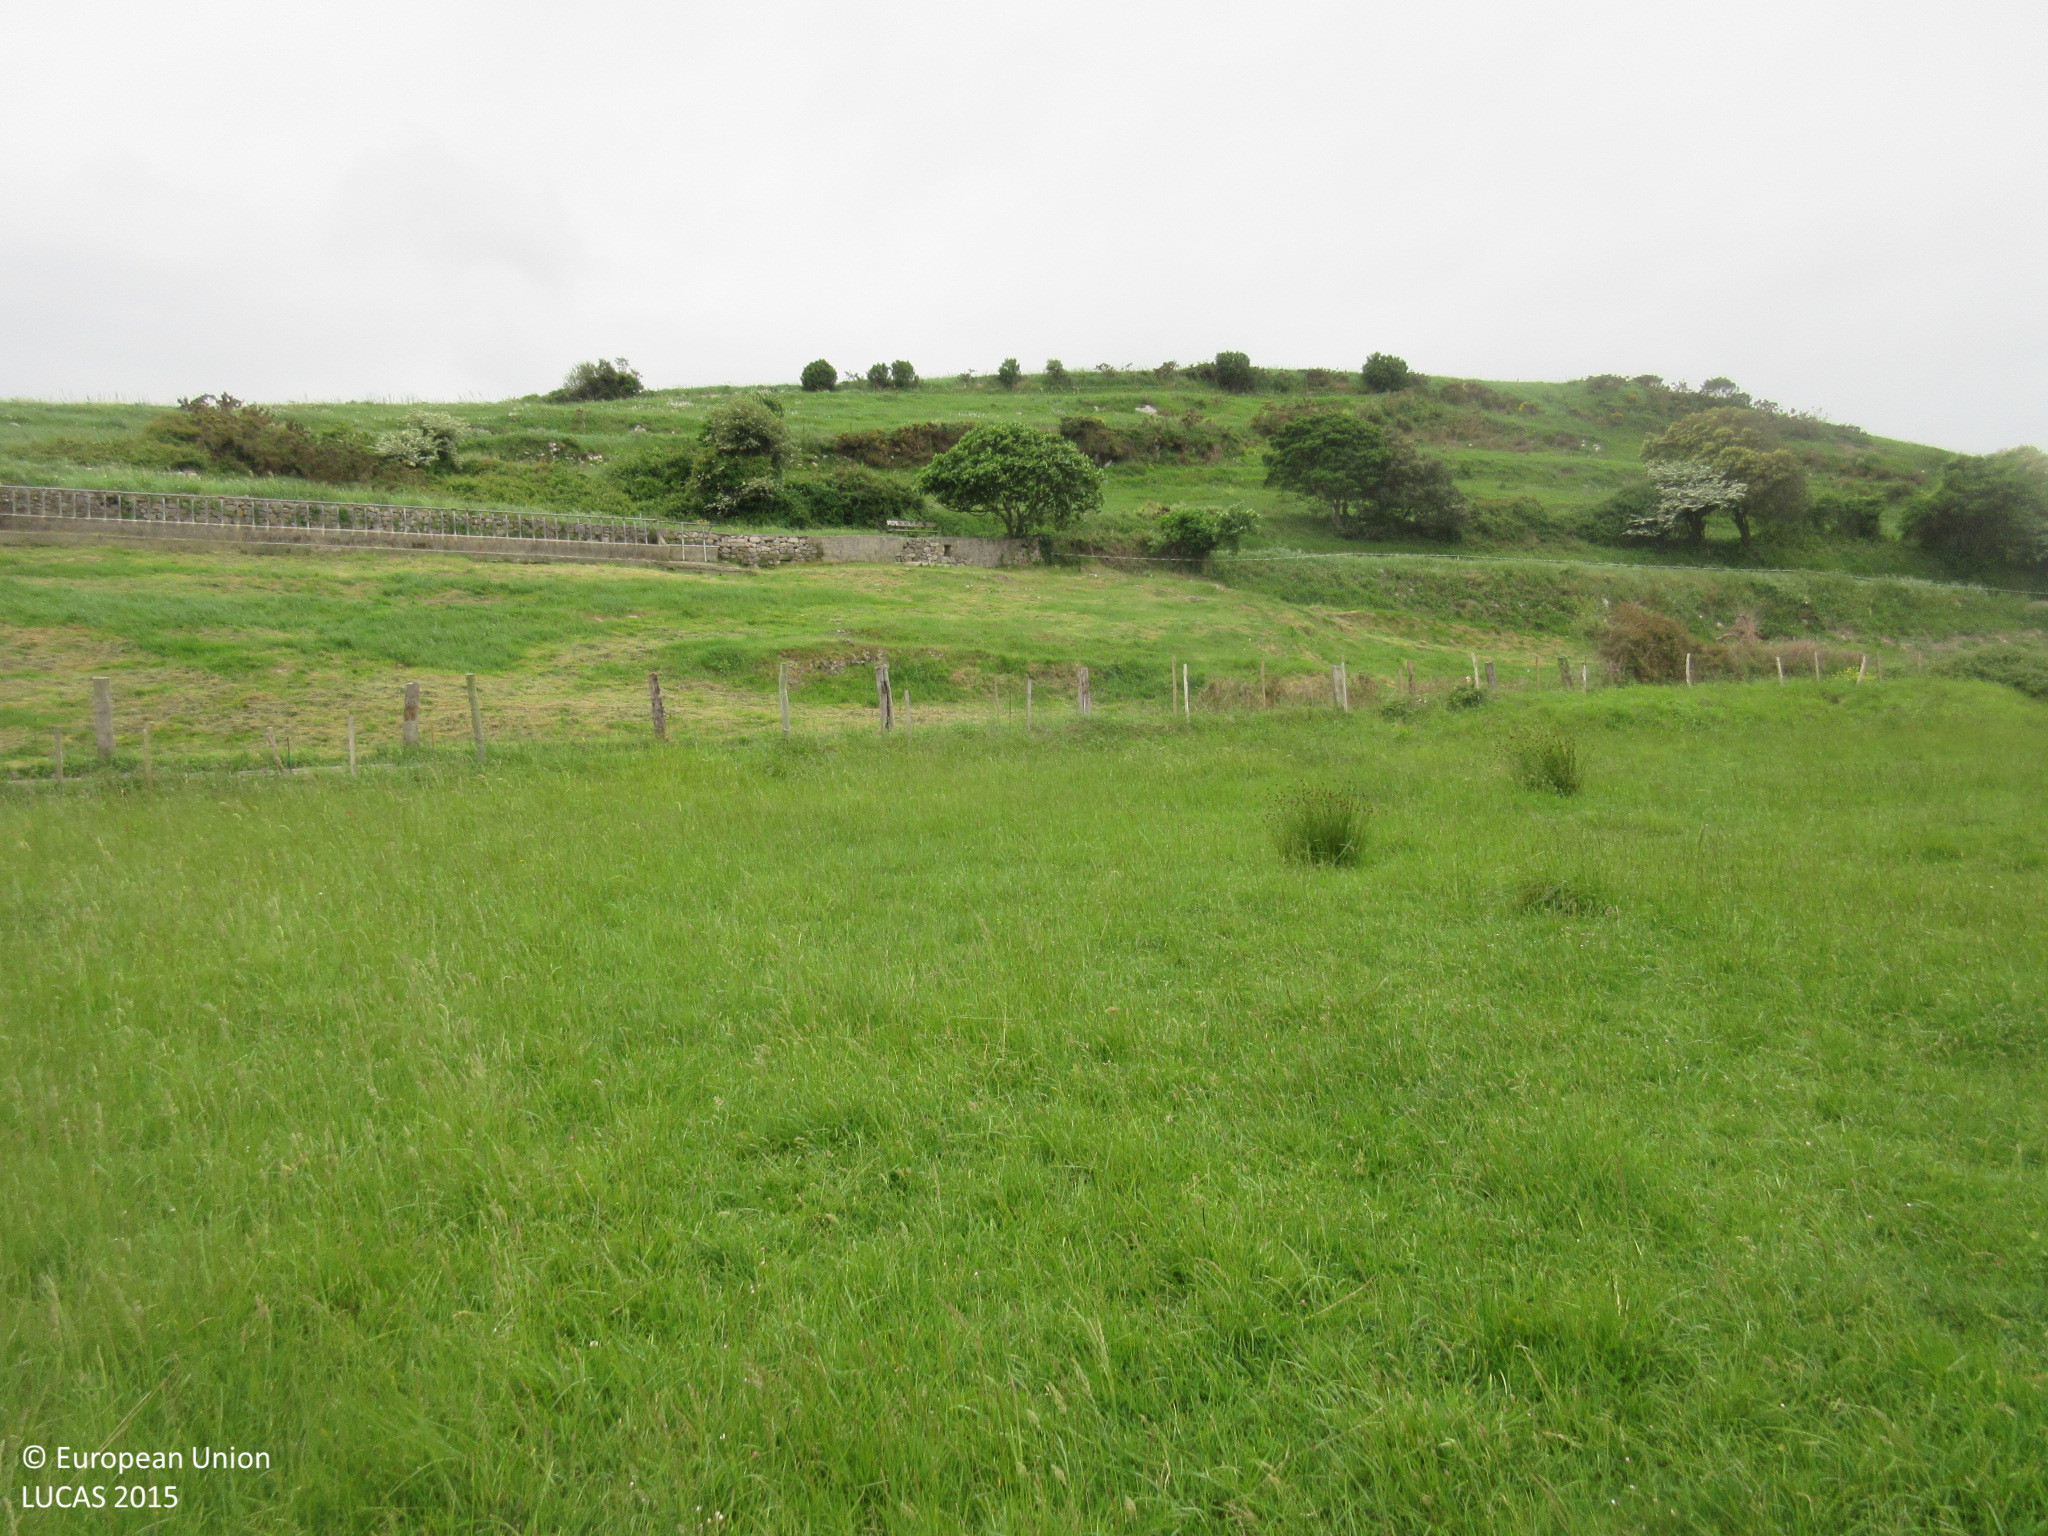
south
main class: Grassland
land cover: Grassland without tree/shrub cover
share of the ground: > 75 %
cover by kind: herbaceous plants 100 %
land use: Agriculture (excluding fallow land and kitchen gardens)
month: May
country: ES
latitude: 43.3891
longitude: -4.4412
